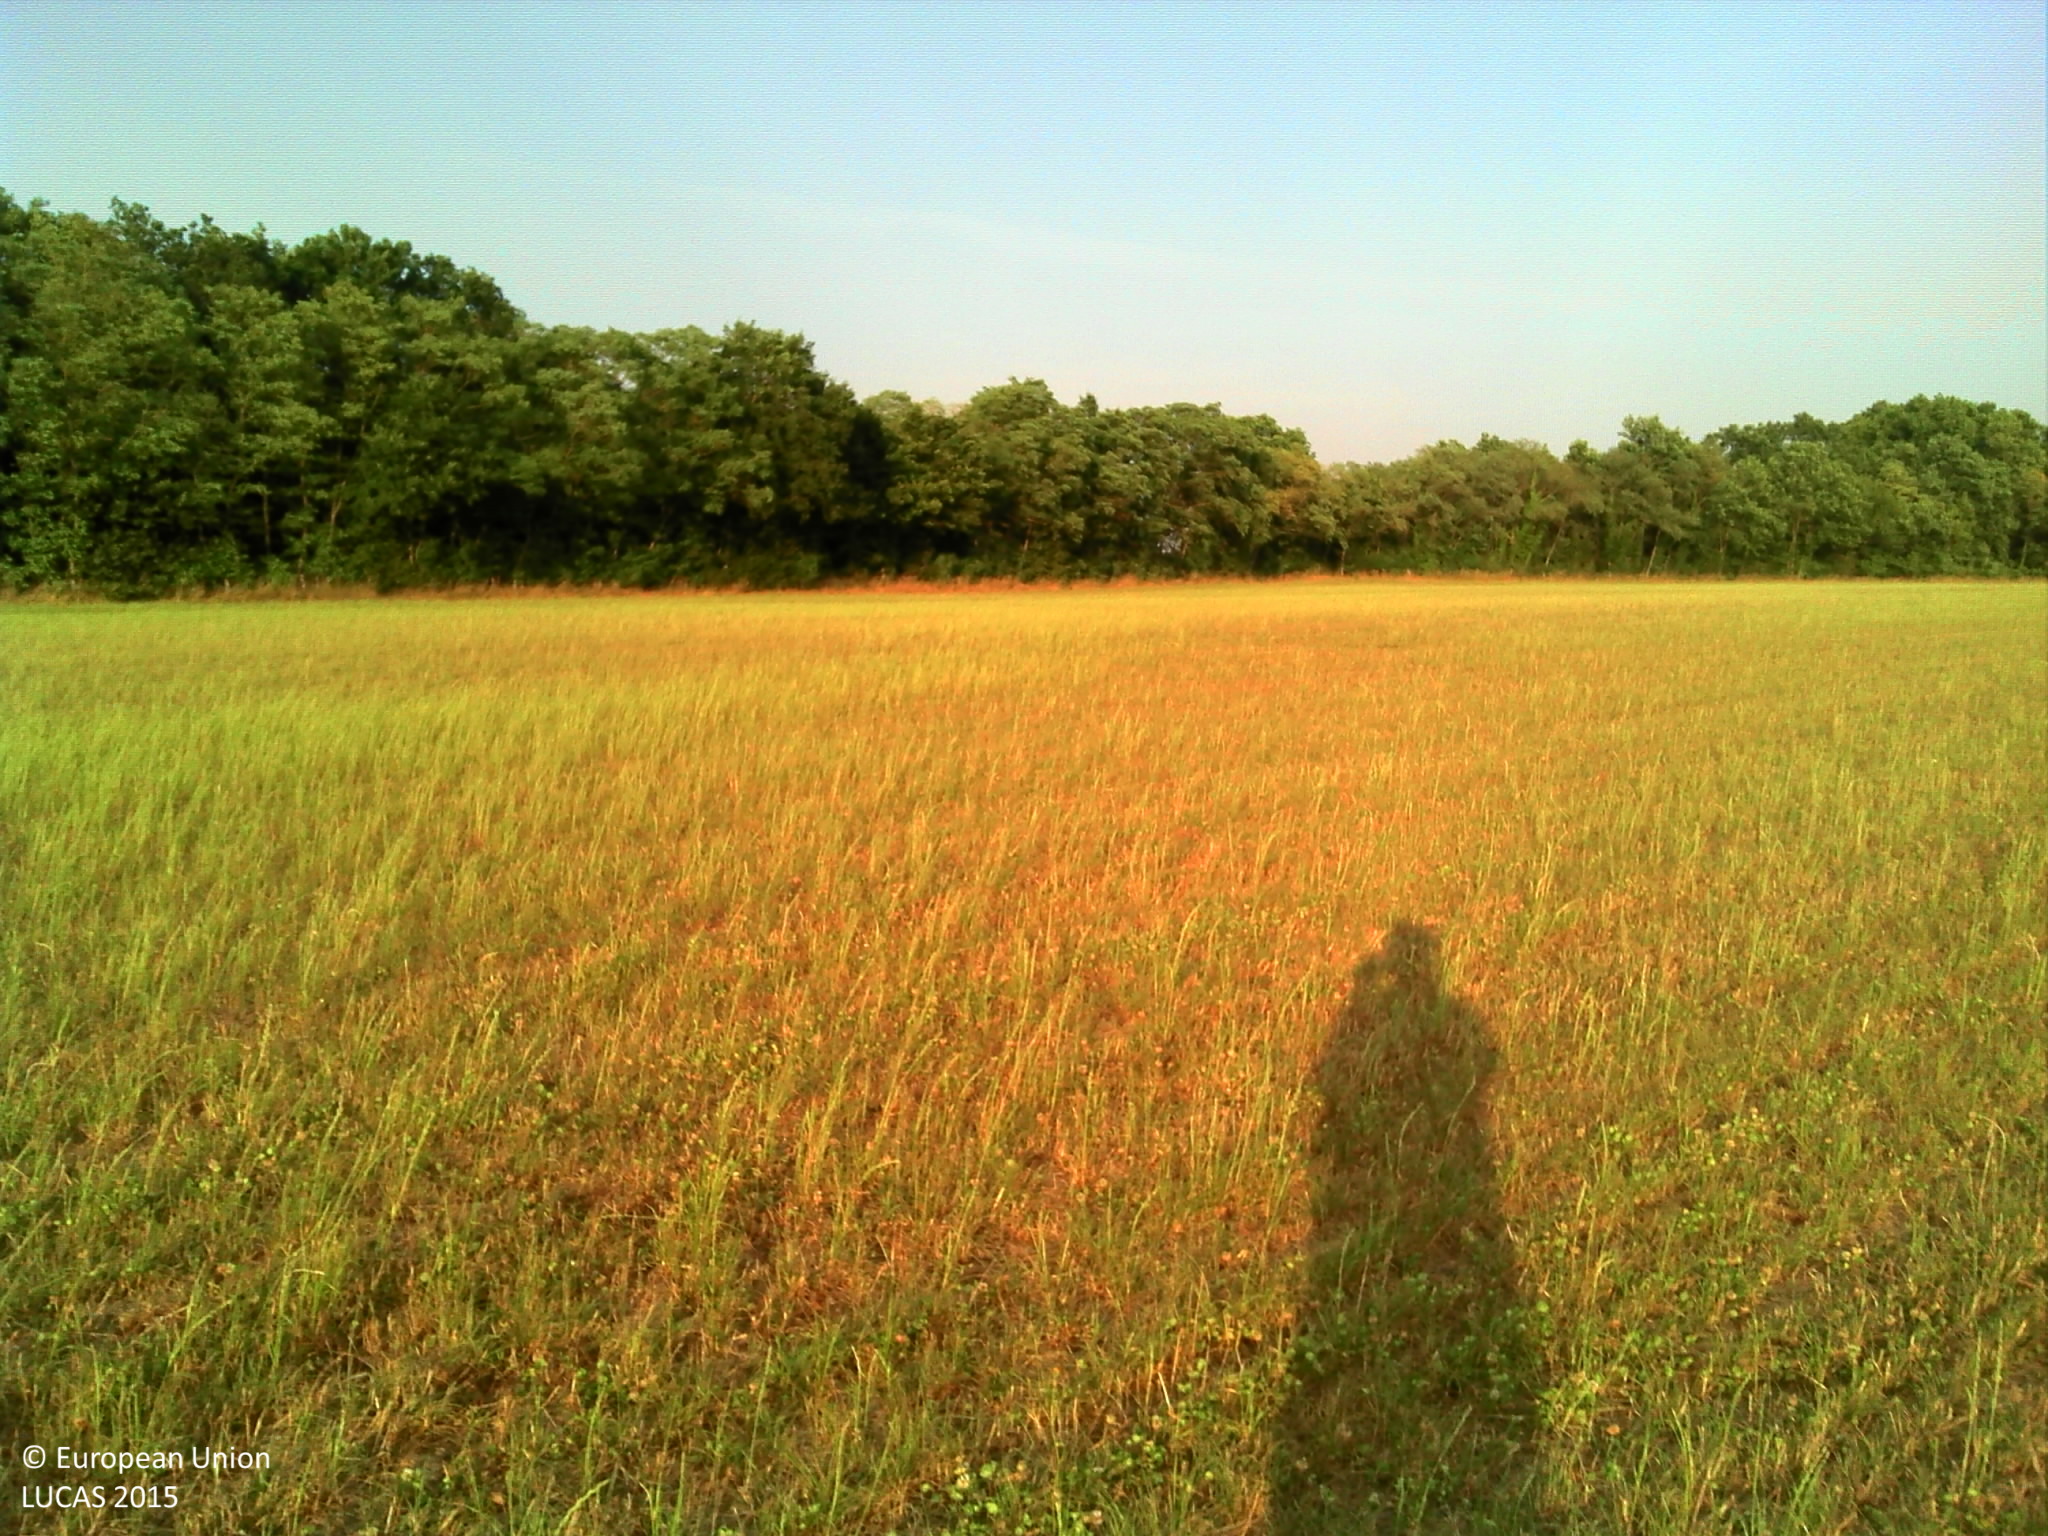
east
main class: Cropland
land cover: Temporary grasslands
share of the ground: > 75 %
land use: Agriculture (excluding fallow land and kitchen gardens)
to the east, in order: Temporary grasslands; Fences; Lines of trees; Grass margins; Paved roads, cycling and walking lanes; Grass margins; Ditches and canals; Broadleaved woodland; Fences; Grassland without tree/shrub cover; Fences; Broadleaved woodland; Rivers and streams; Fences; Grassland without tree/shrub cover
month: July
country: FR
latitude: 46.7538
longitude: 3.5706
